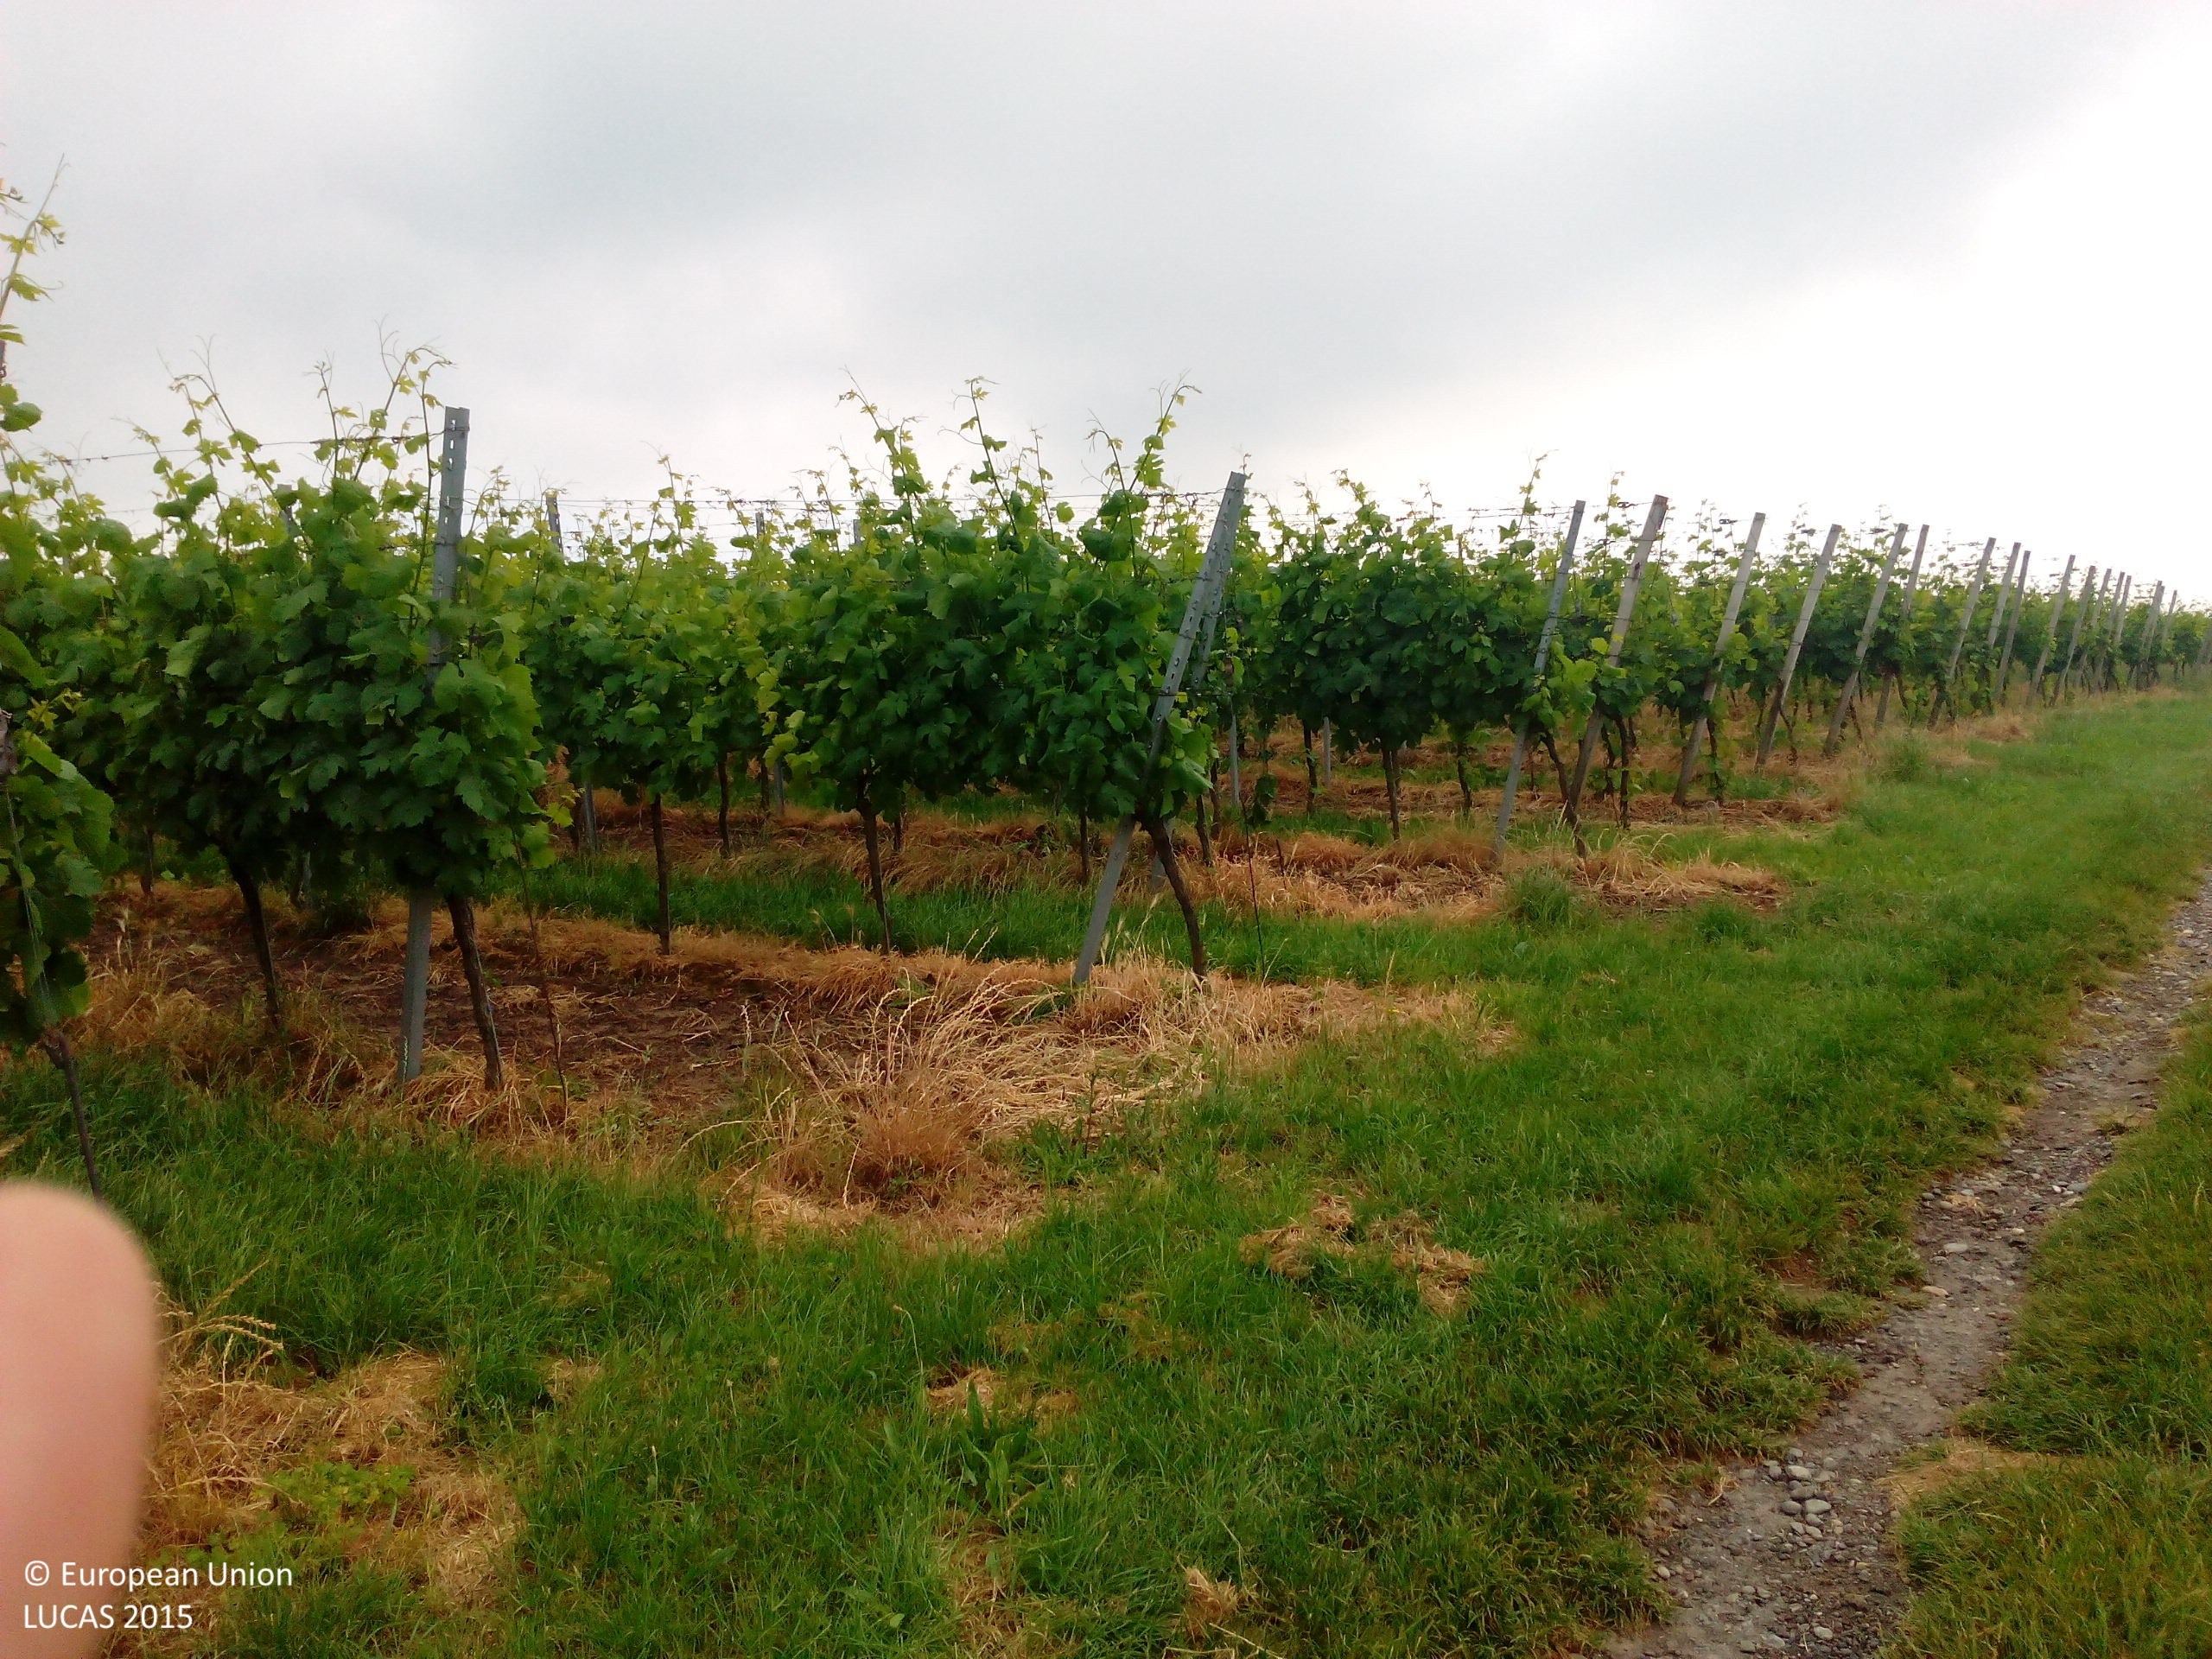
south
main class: Cropland
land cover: Vineyards
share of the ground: 25 - 50 %
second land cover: Grassland without tree/shrub cover
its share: 50 - 75 %
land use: Agriculture (excluding fallow land and kitchen gardens)
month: June
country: DE
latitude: 48.1259
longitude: 7.6231
